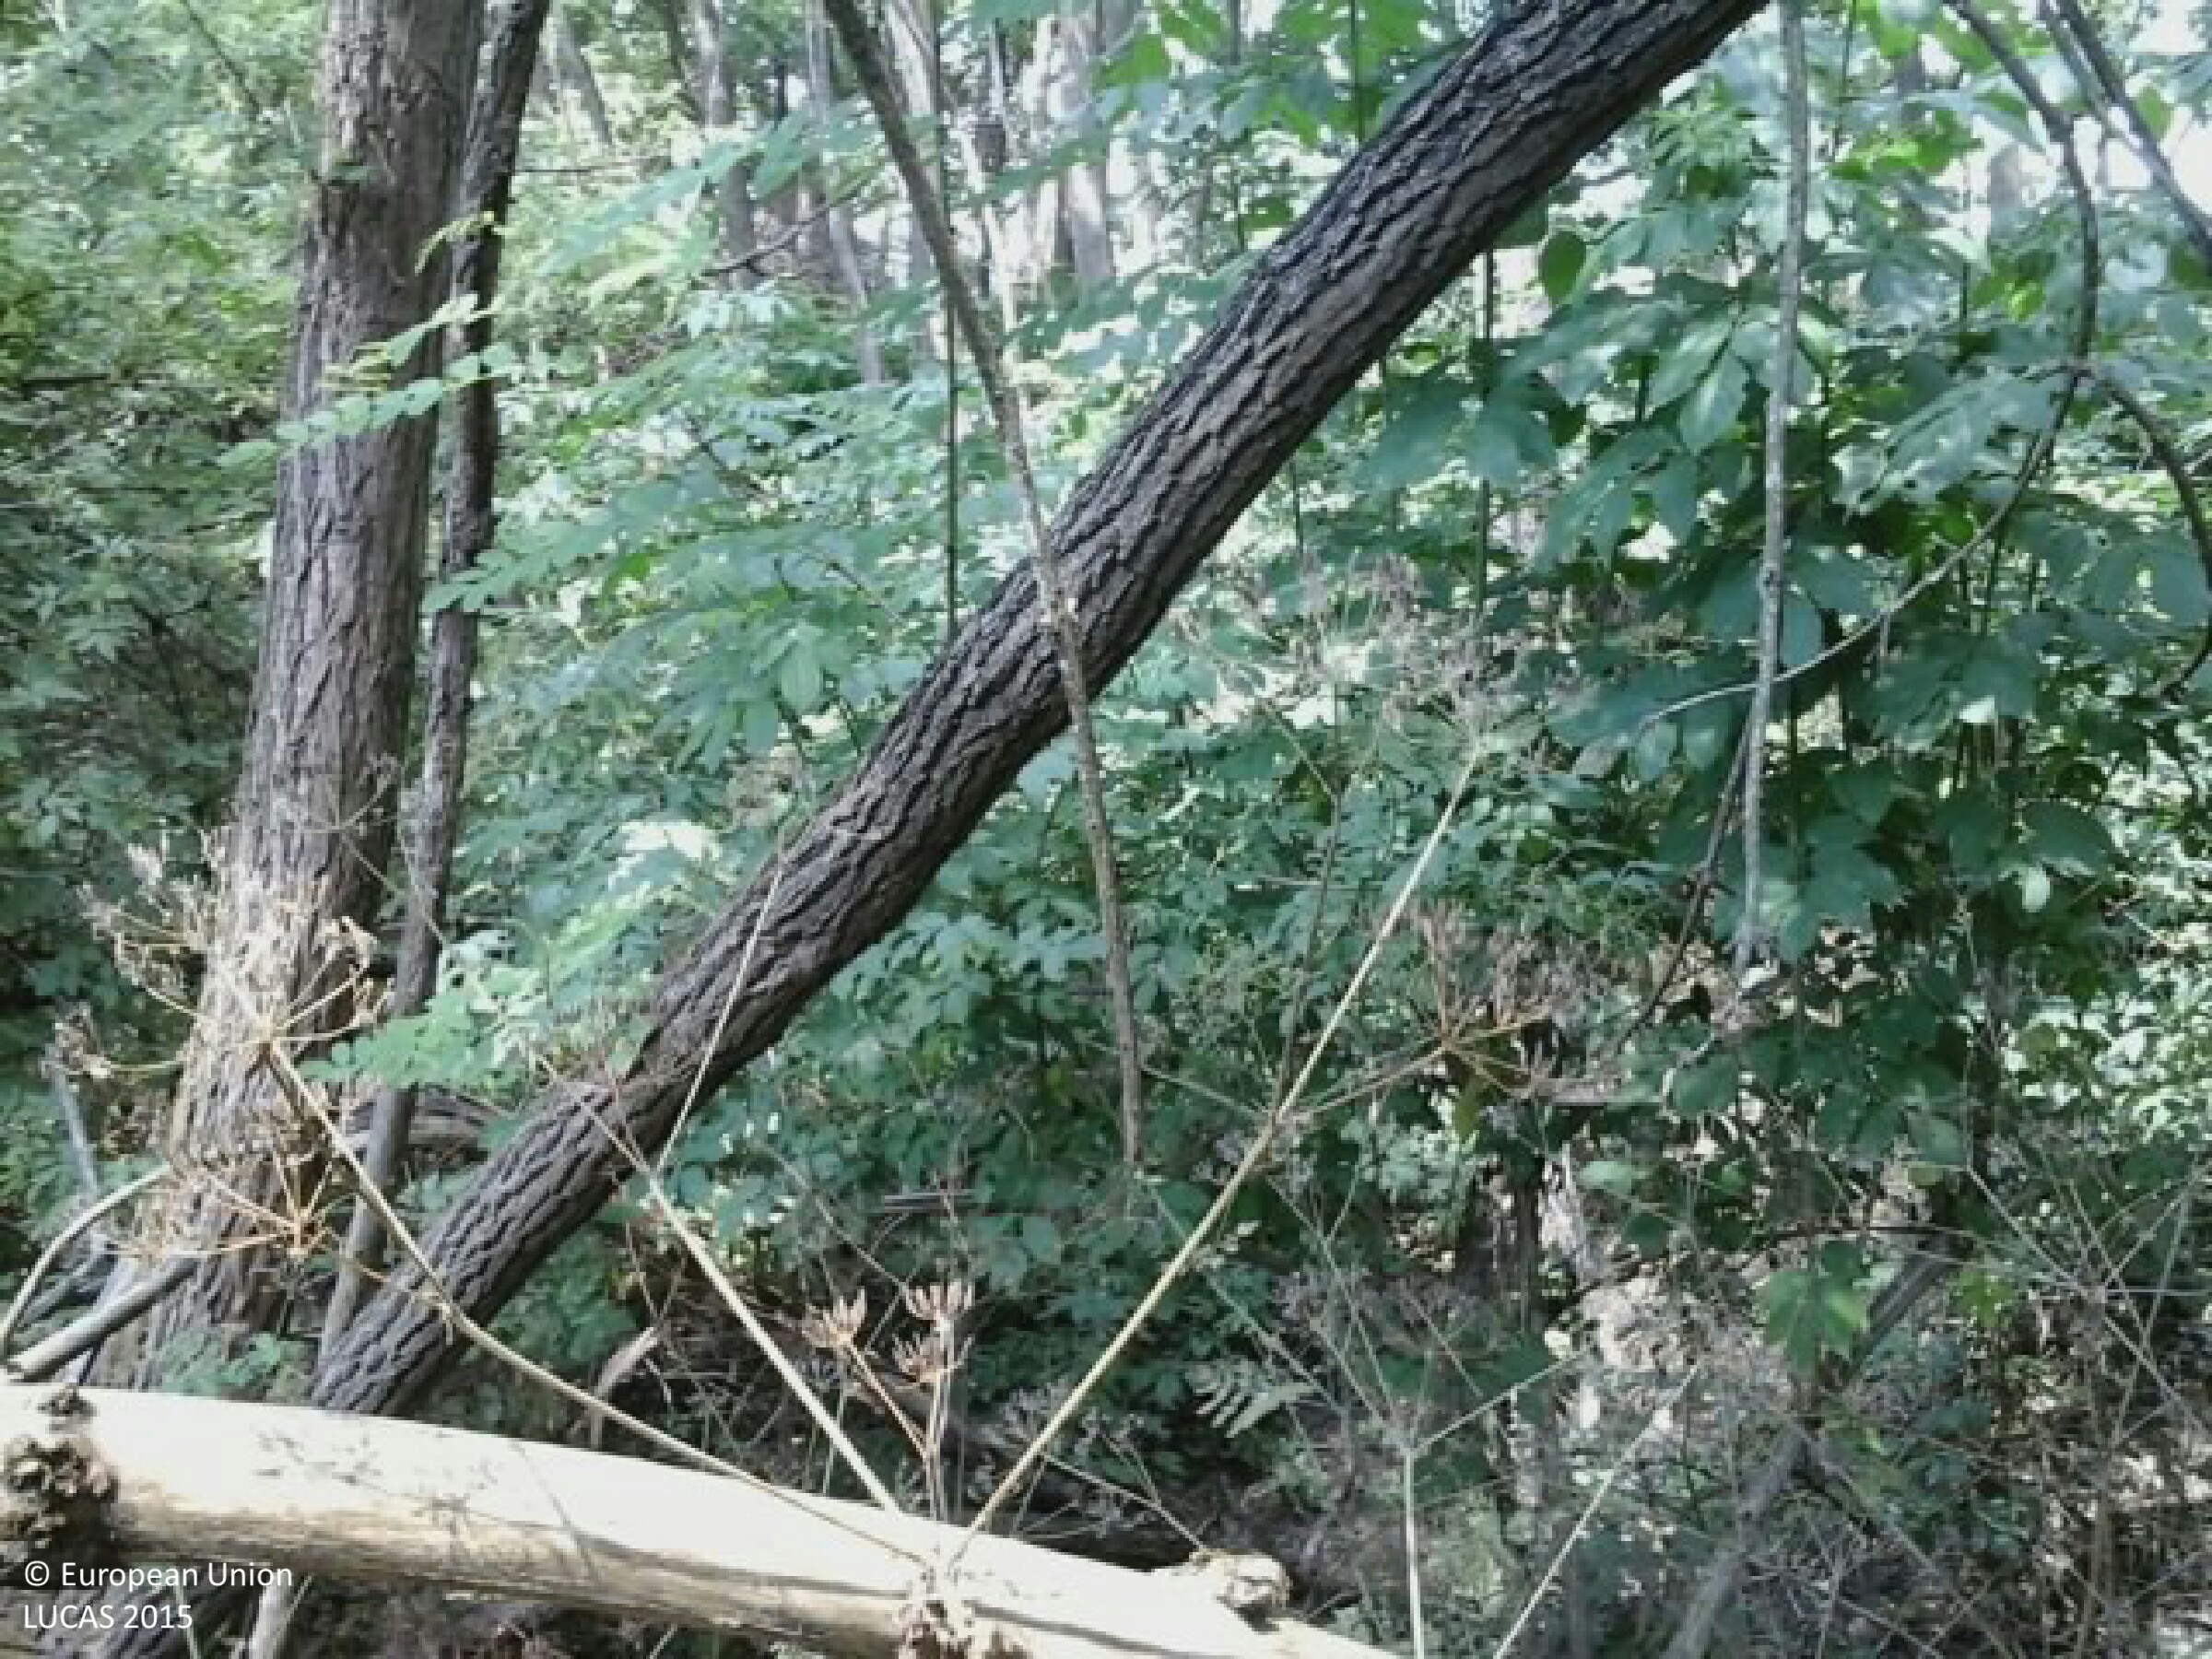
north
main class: Woodland
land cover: Broadleaved woodland
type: mesophytic deciduous forest
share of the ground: > 75 %
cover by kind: broadleaved forest trees 100 %
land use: Forestry
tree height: > 5 m
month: July
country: HU
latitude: 47.7712
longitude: 19.3485
